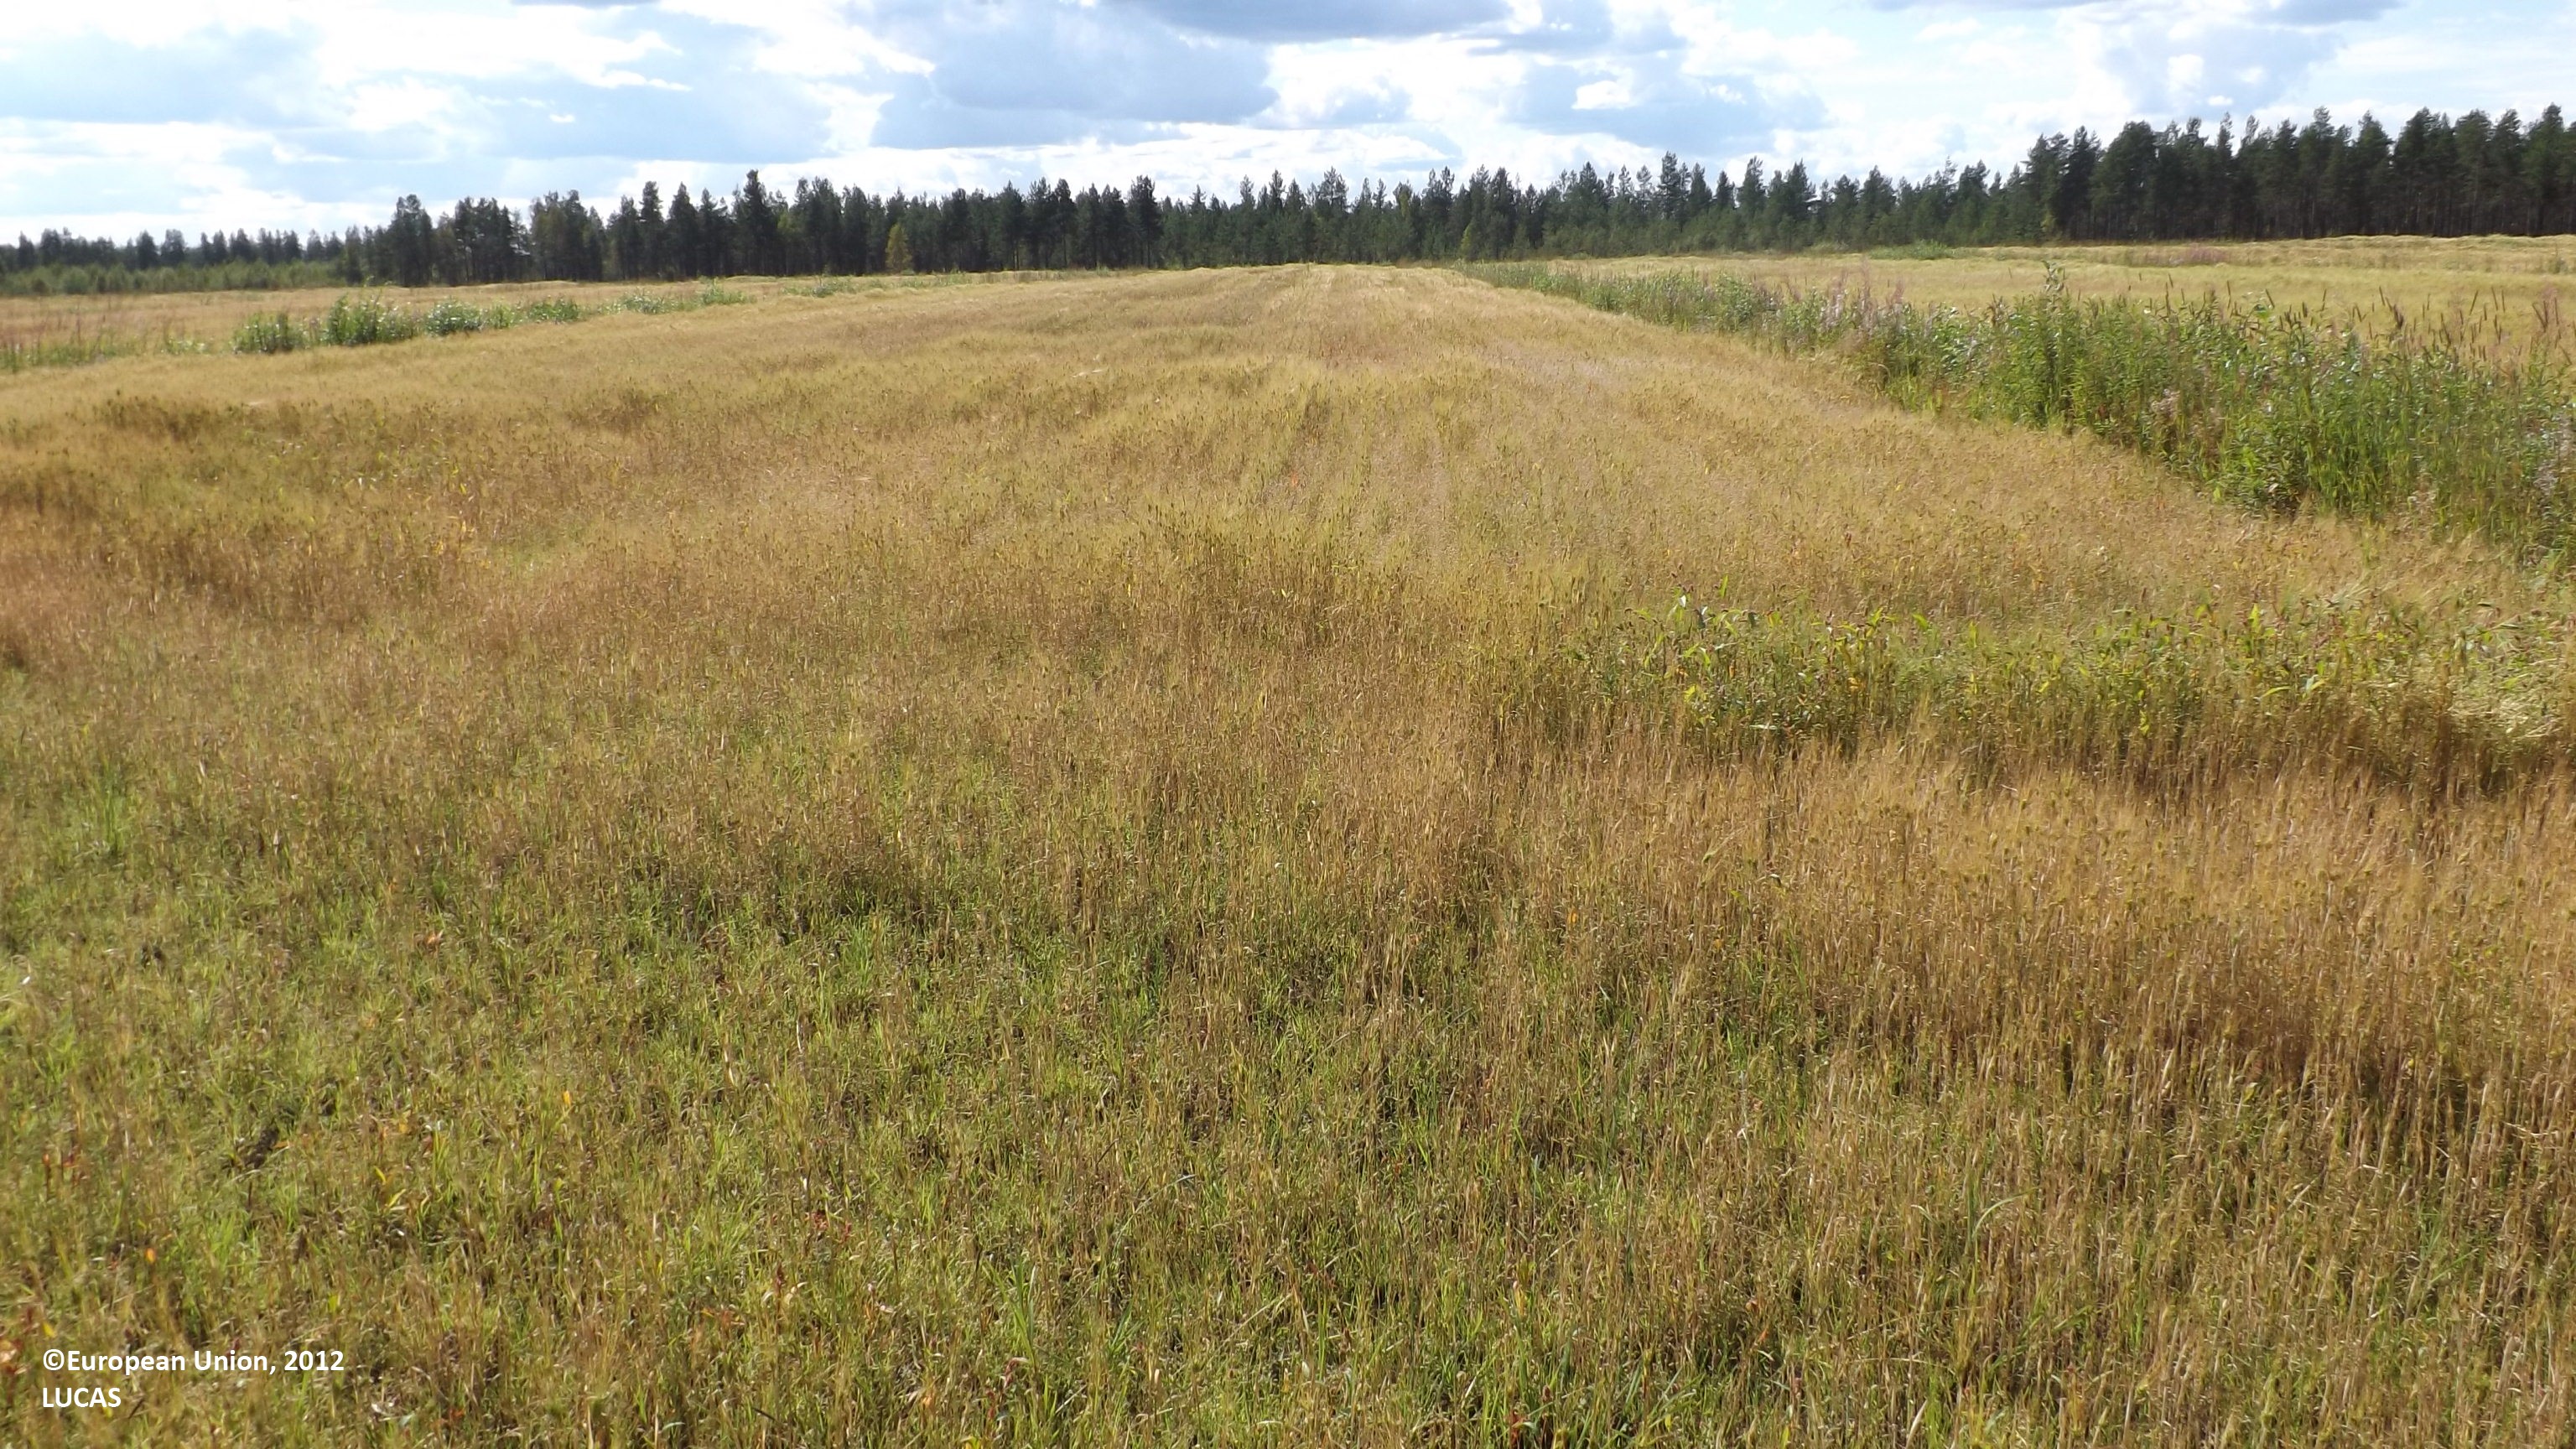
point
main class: Cropland
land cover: Barley
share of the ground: > 75 %
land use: Agriculture (excluding fallow land and kitchen gardens)
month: August
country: FI
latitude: 63.2050
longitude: 24.3764
